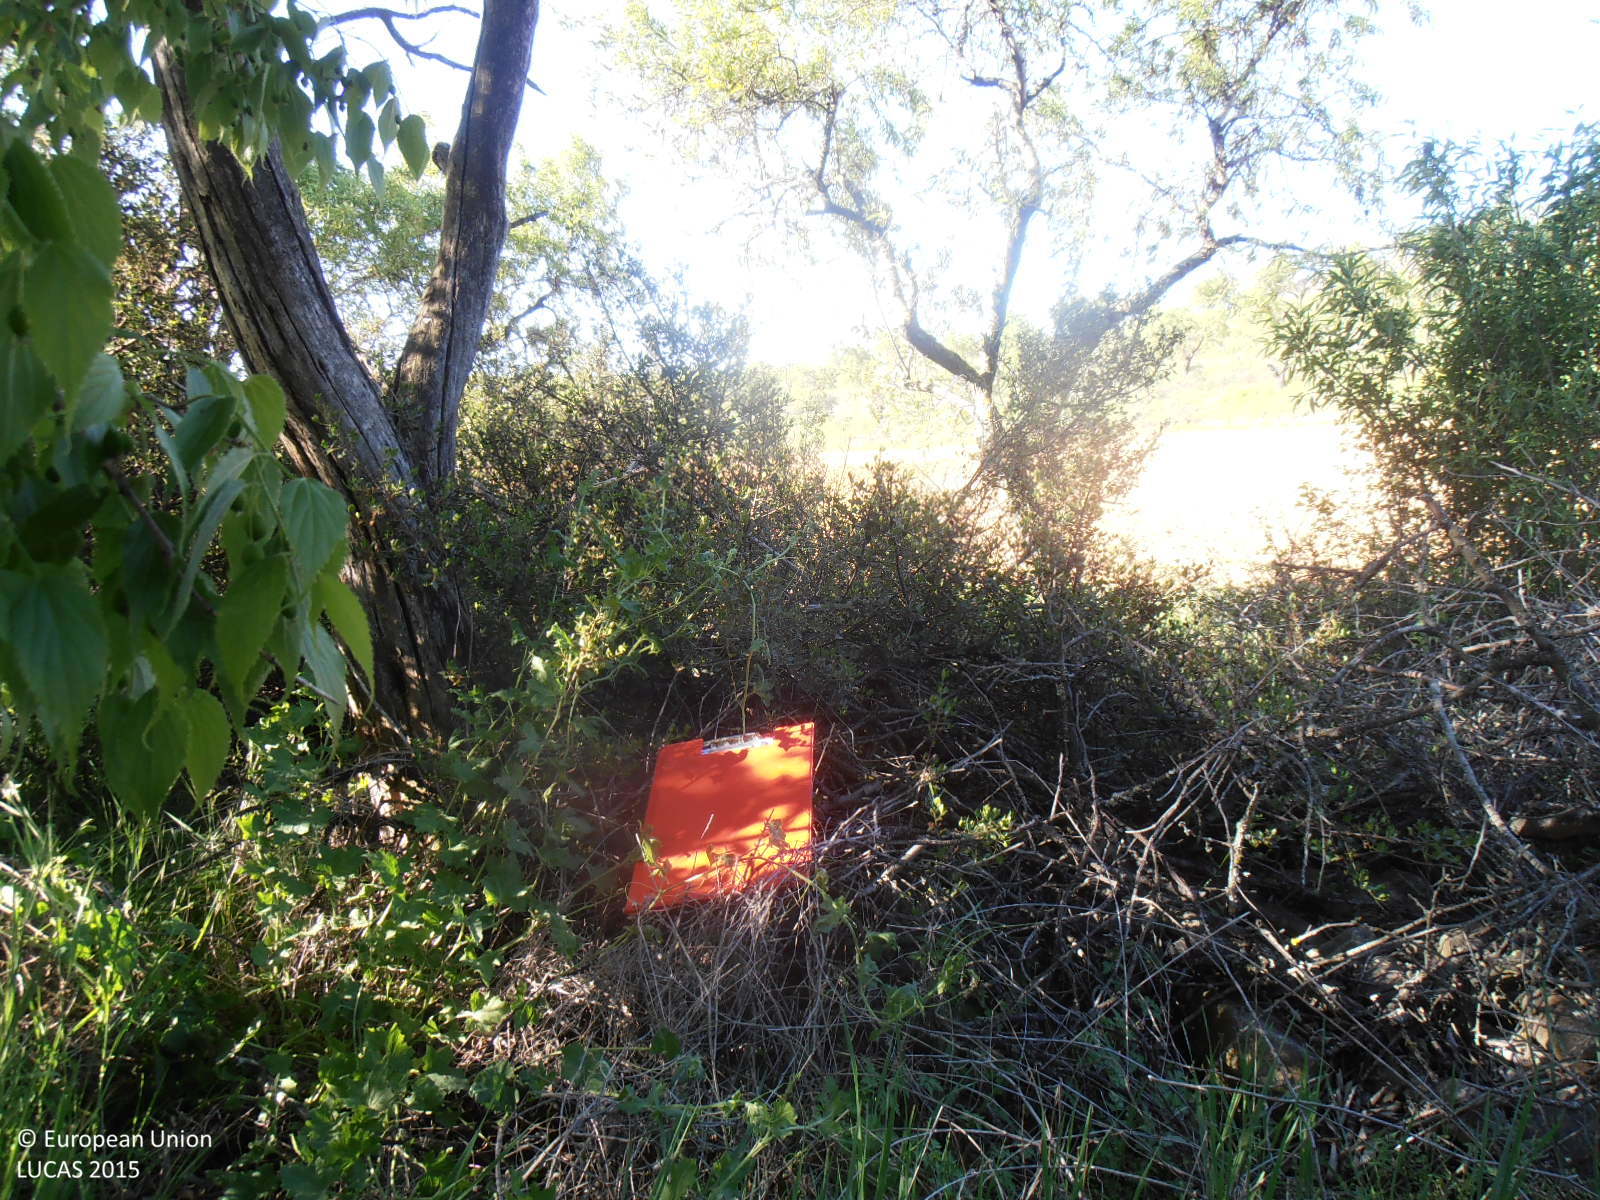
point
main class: Woodland
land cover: Broadleaved woodland
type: thermophilous deciduous forest
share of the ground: > 75 %
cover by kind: broadleaved forest trees 90 %, shrubs 10 %
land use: Semi-natural and natural areas not in use
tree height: < 5 m
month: April
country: ES
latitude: 41.2351
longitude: -0.9832
